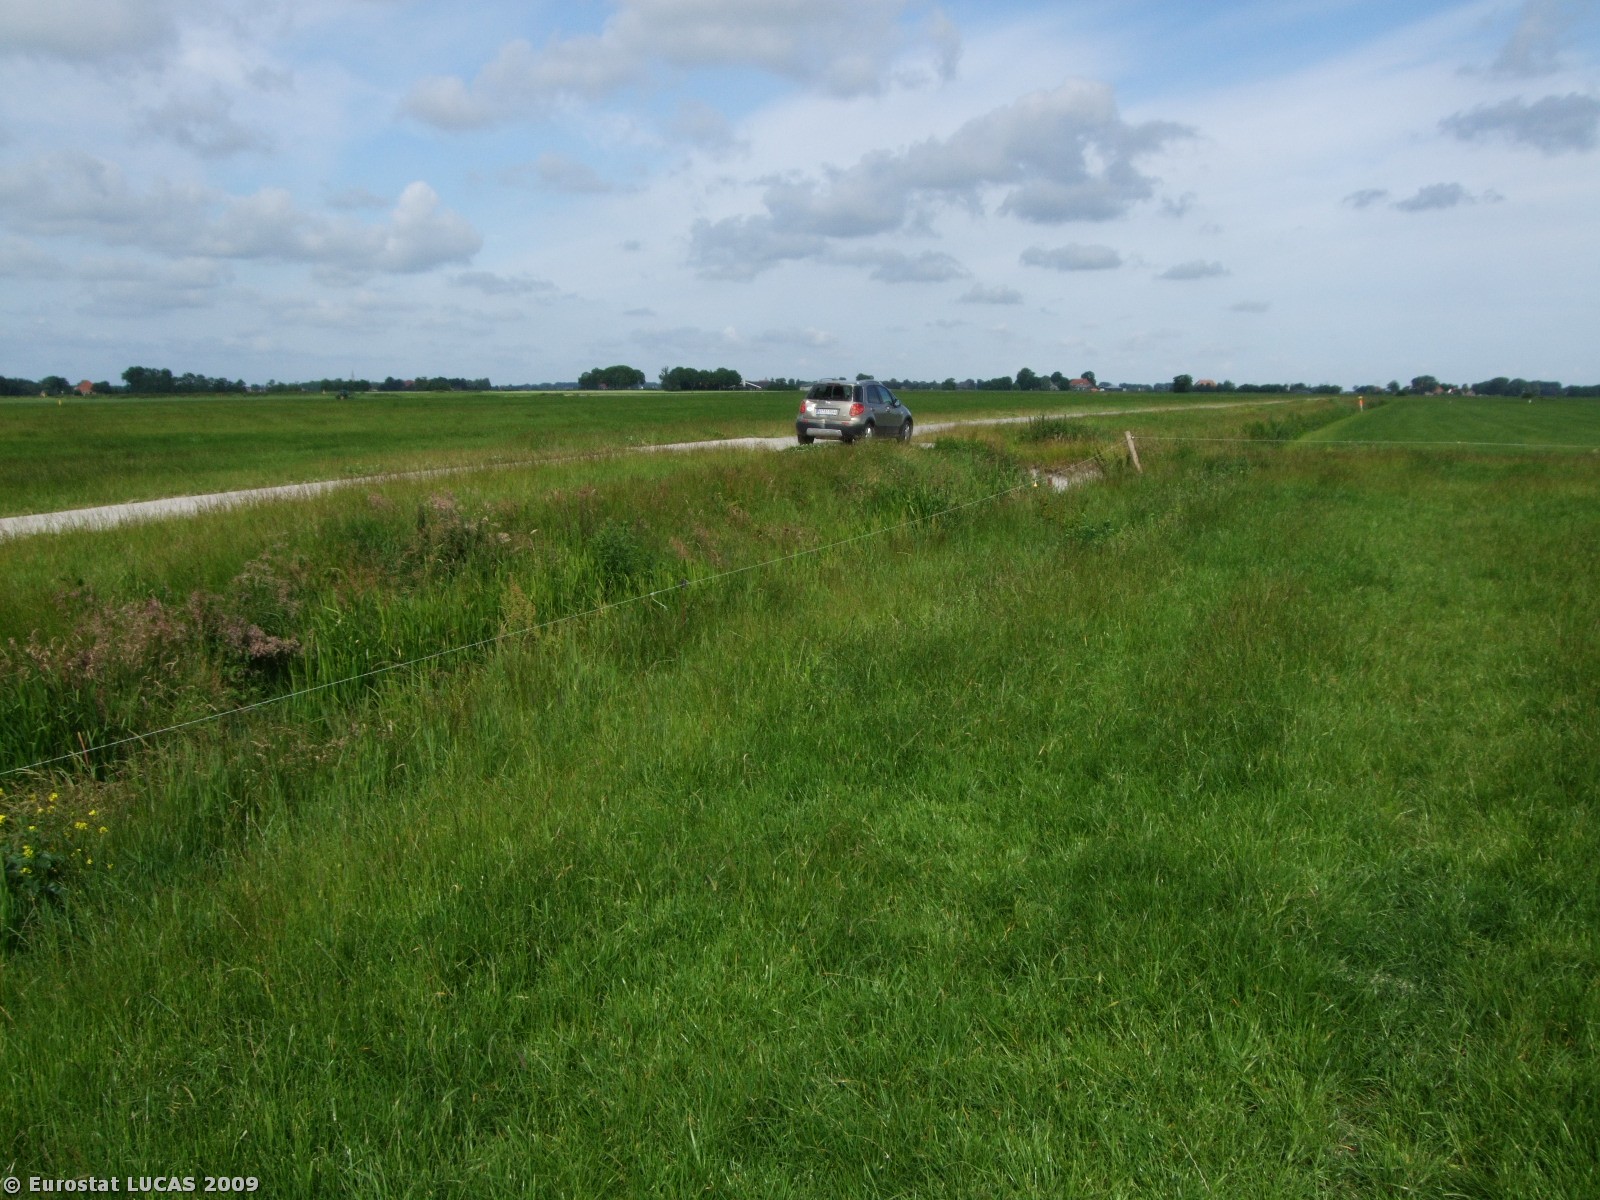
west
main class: Grassland
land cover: Grassland without tree/shrub cover
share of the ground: > 75 %
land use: Agriculture (excluding fallow land and kitchen gardens)
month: June
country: NL
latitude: 53.0530
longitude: 5.6277
